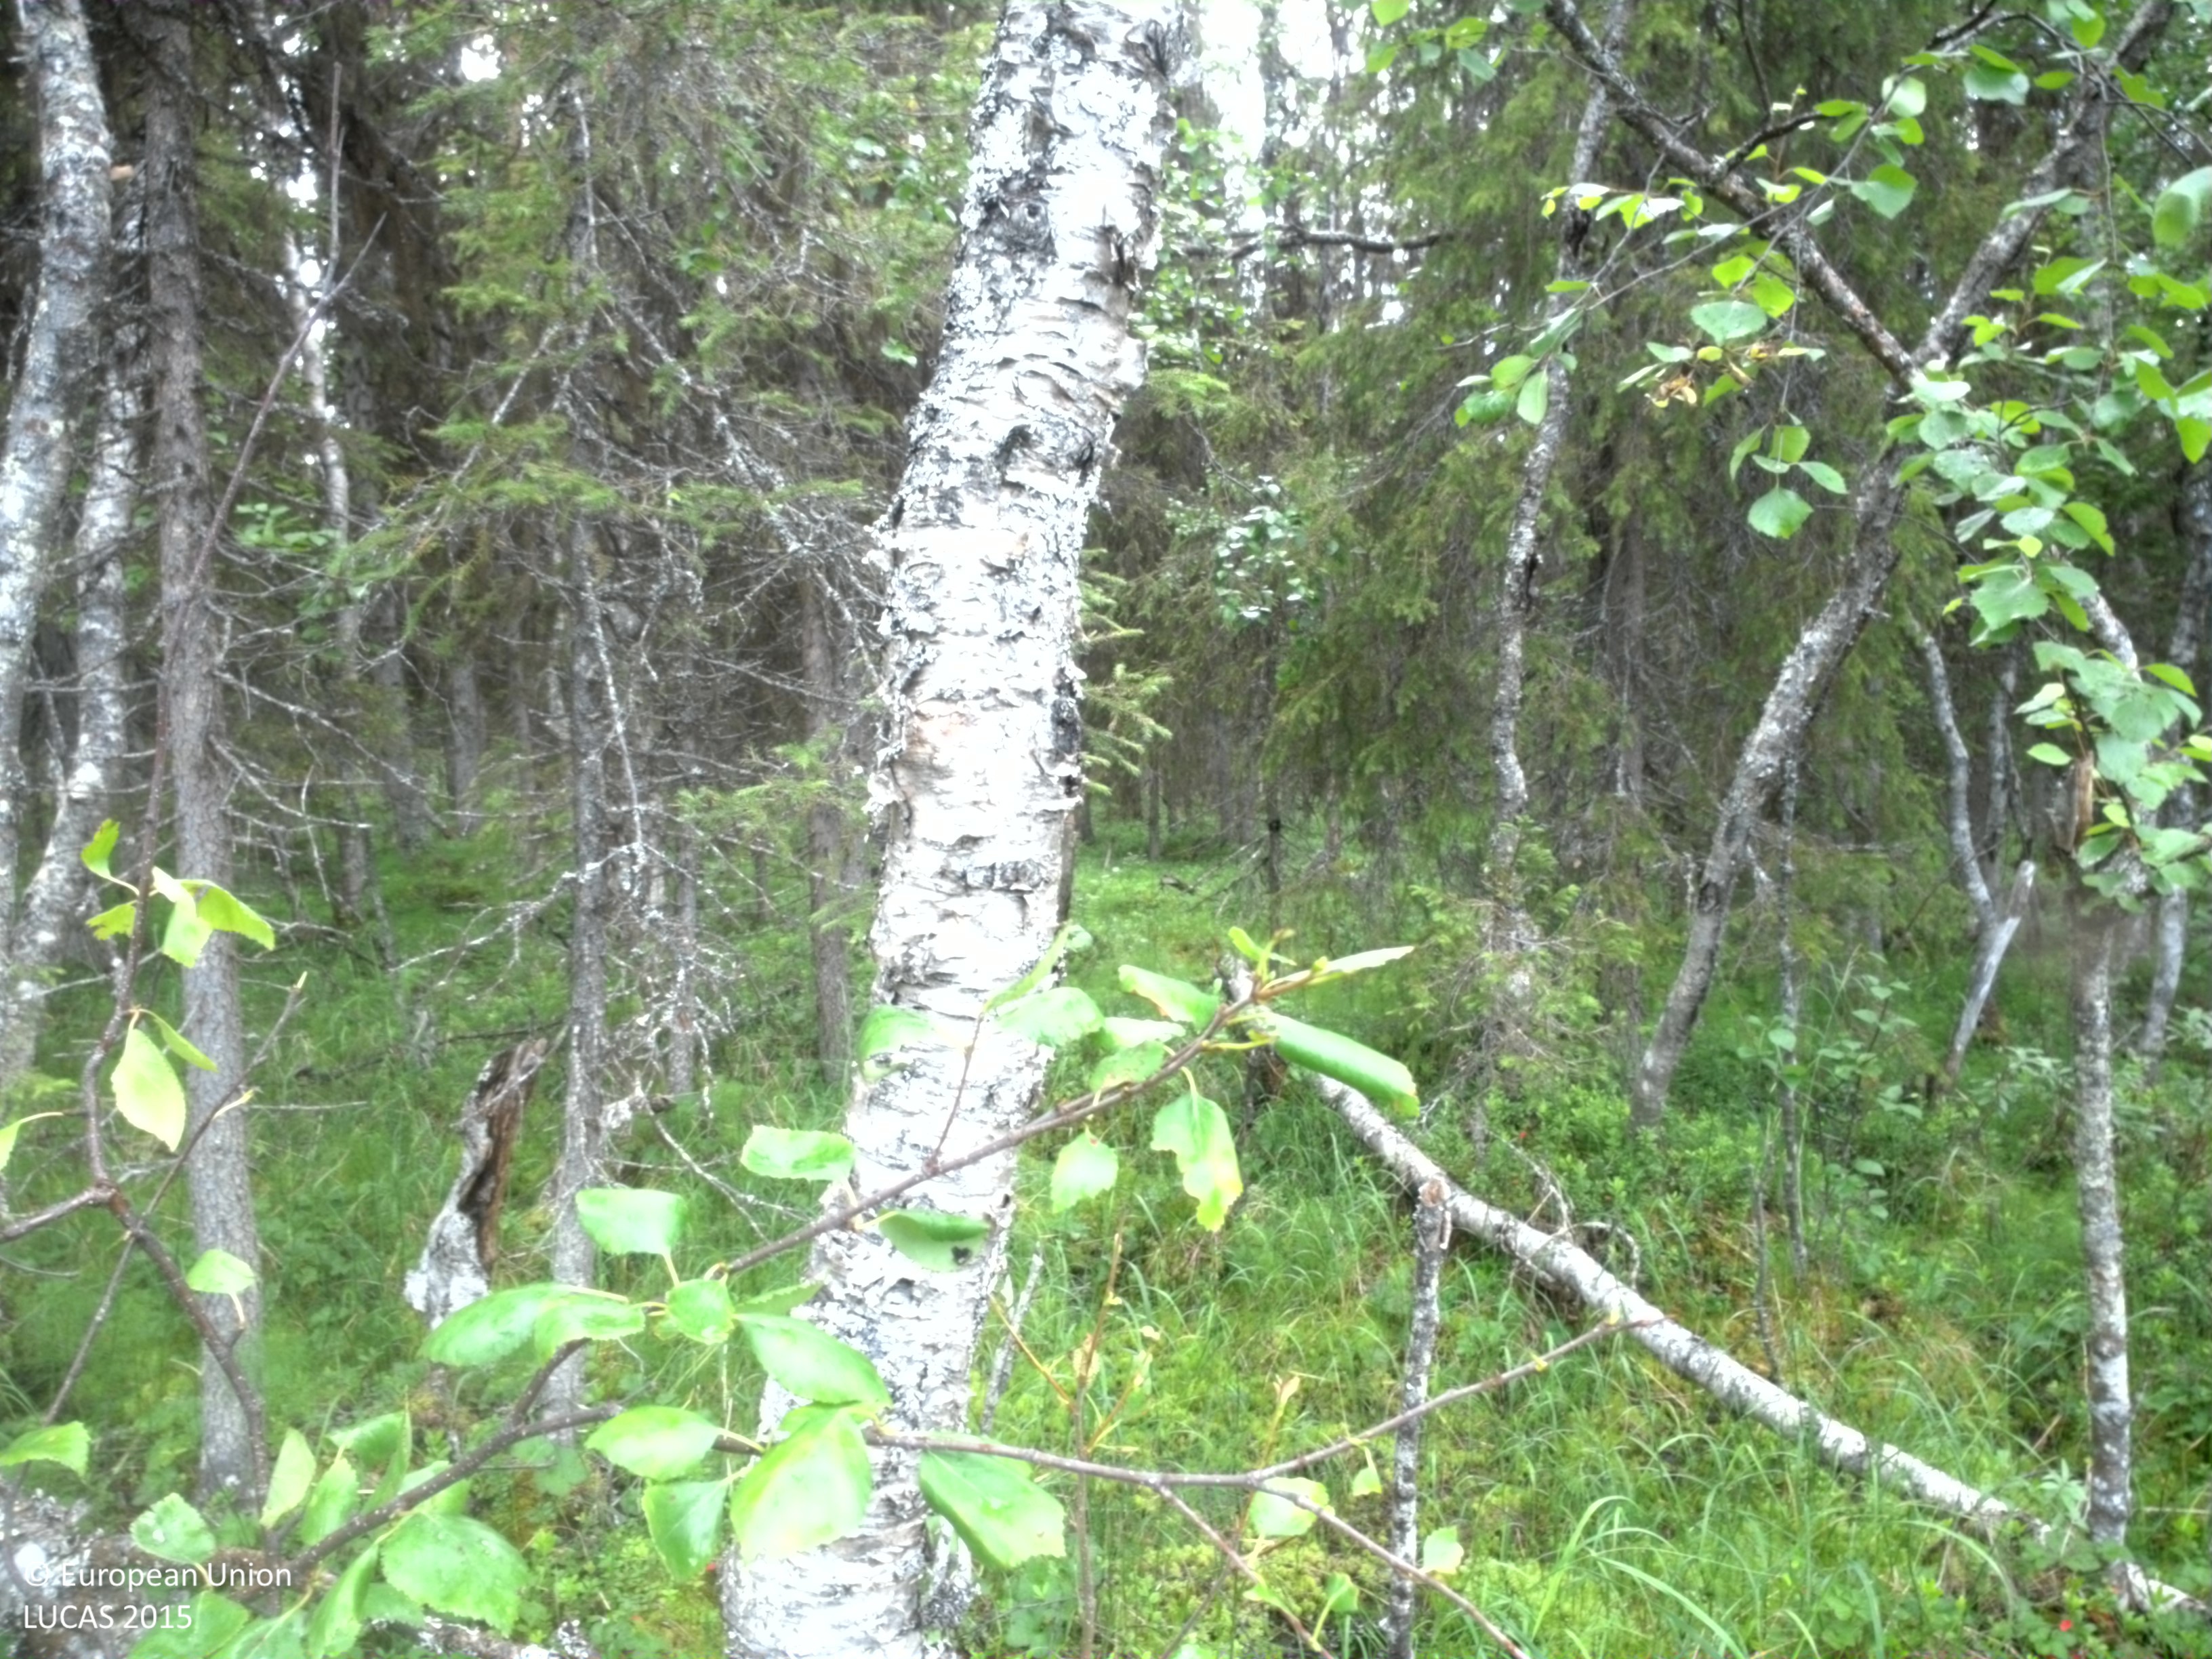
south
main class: Woodland
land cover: Spruce dominated mixed woodland
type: mire and swamp forests
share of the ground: 25 - 50 %
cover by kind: shrubs 45 %, coniferous forest trees 25 %, broadleaved forest trees 15 %, lichens and mosses 10 %, herbaceous plants 5 %
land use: Semi-natural and natural areas not in use
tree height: > 5 m
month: July
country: SE
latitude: 66.4246
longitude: 19.5657
